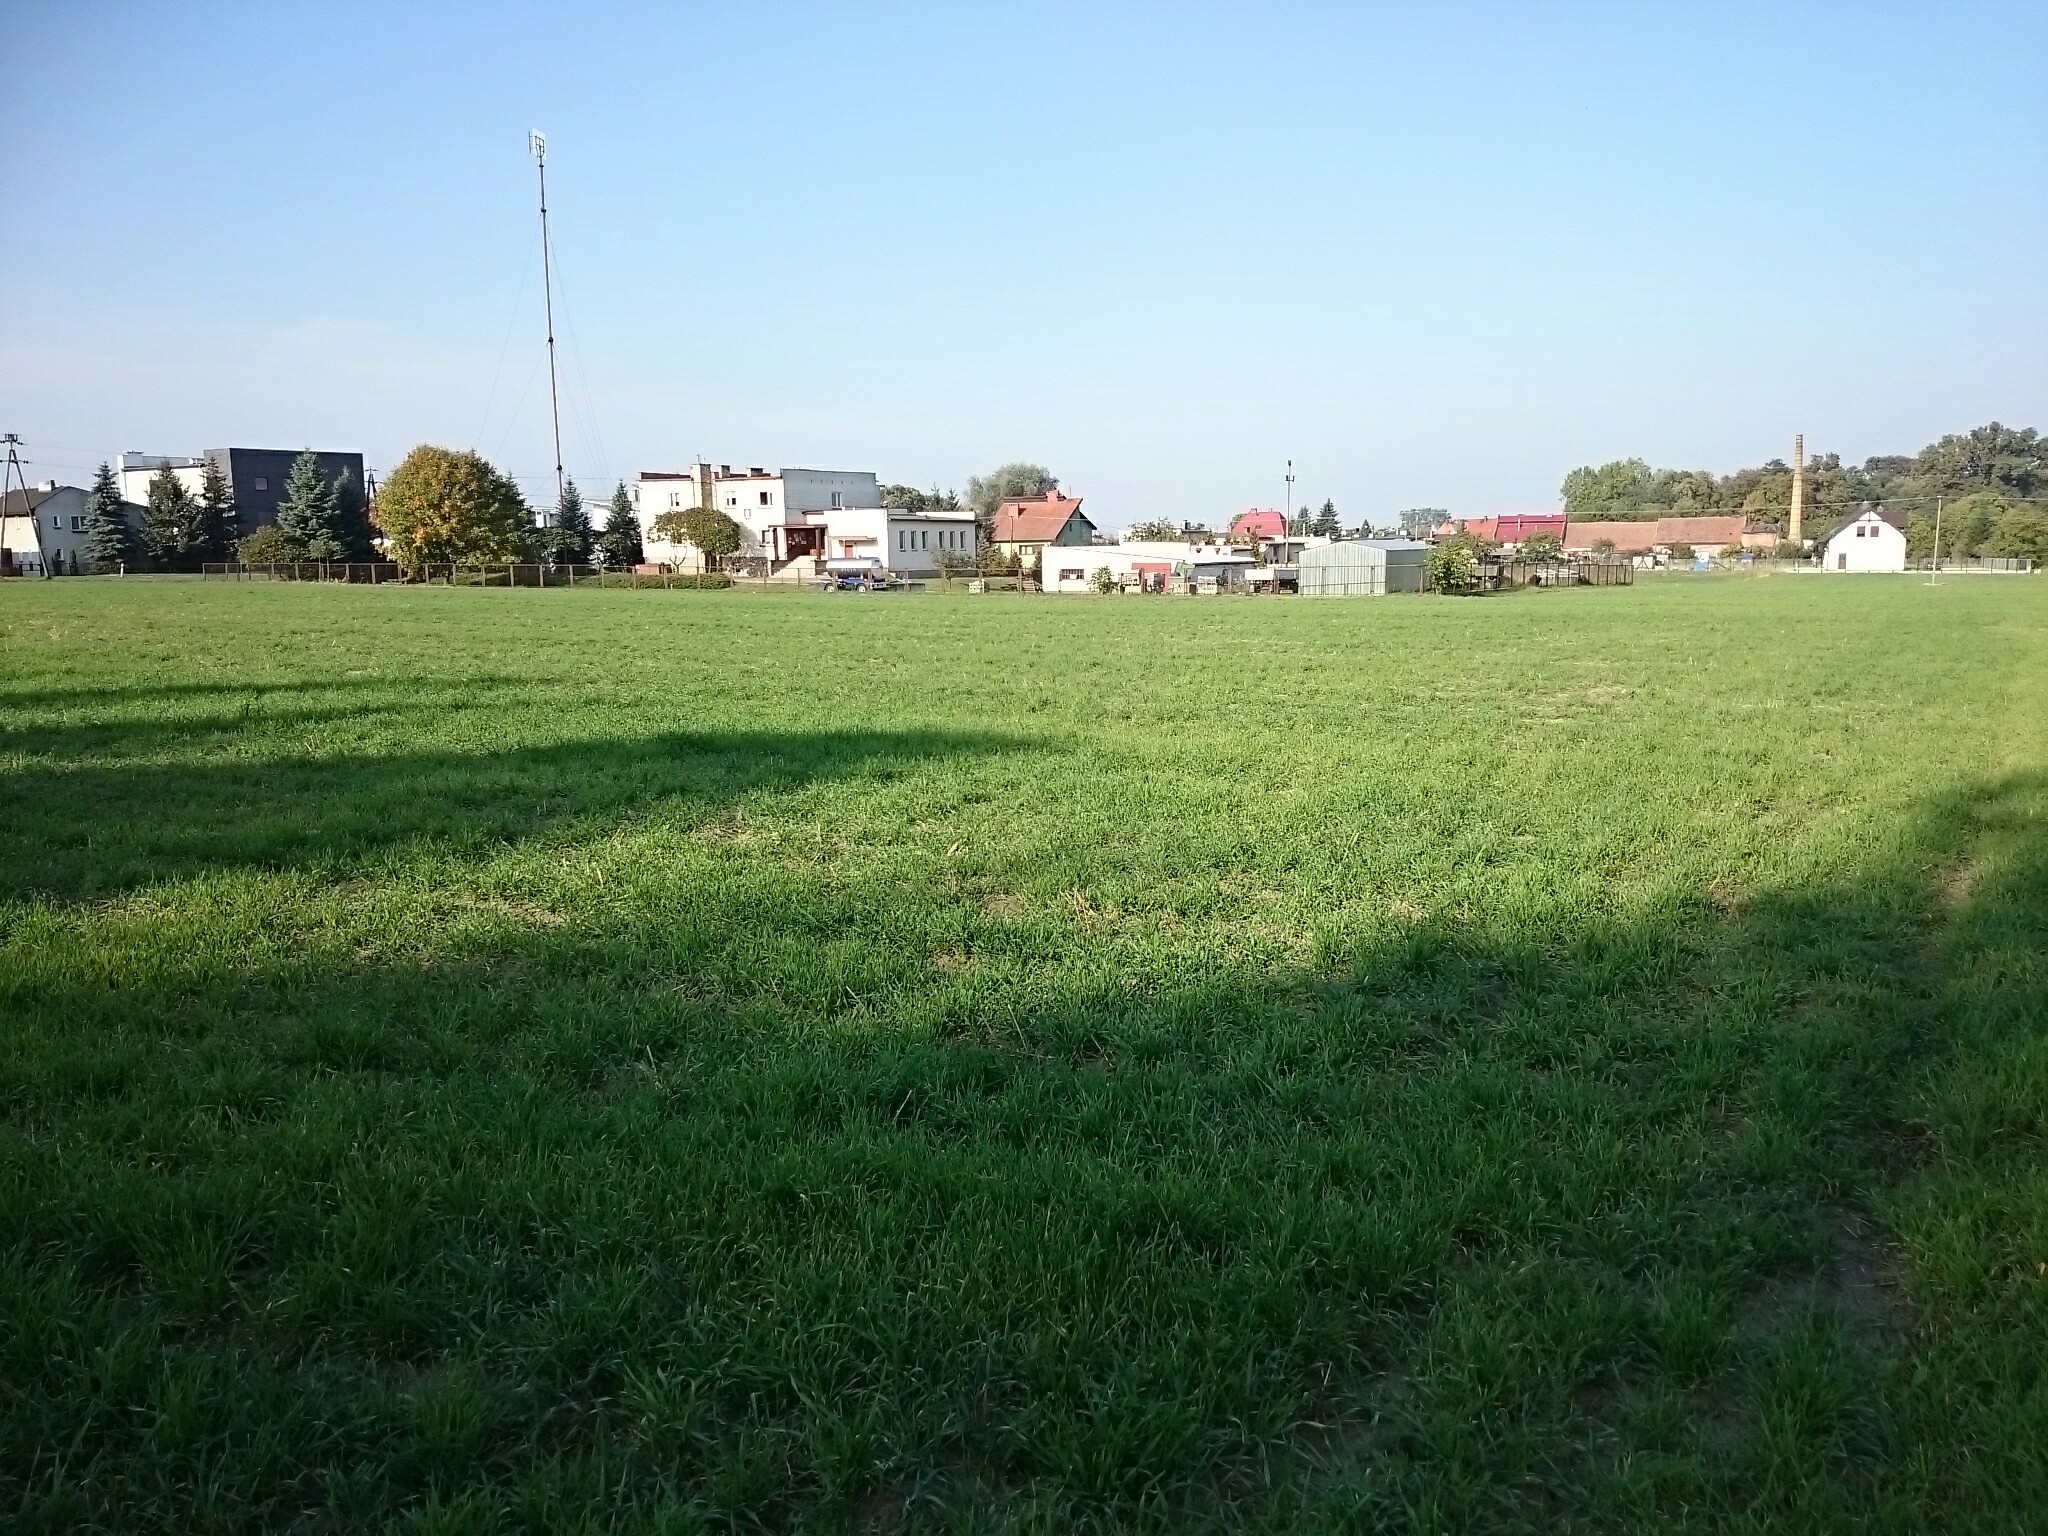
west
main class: Cropland
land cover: Temporary grasslands
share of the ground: > 75 %
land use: Agriculture (excluding fallow land and kitchen gardens)
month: September
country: PL
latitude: 51.6251
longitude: 17.3646
